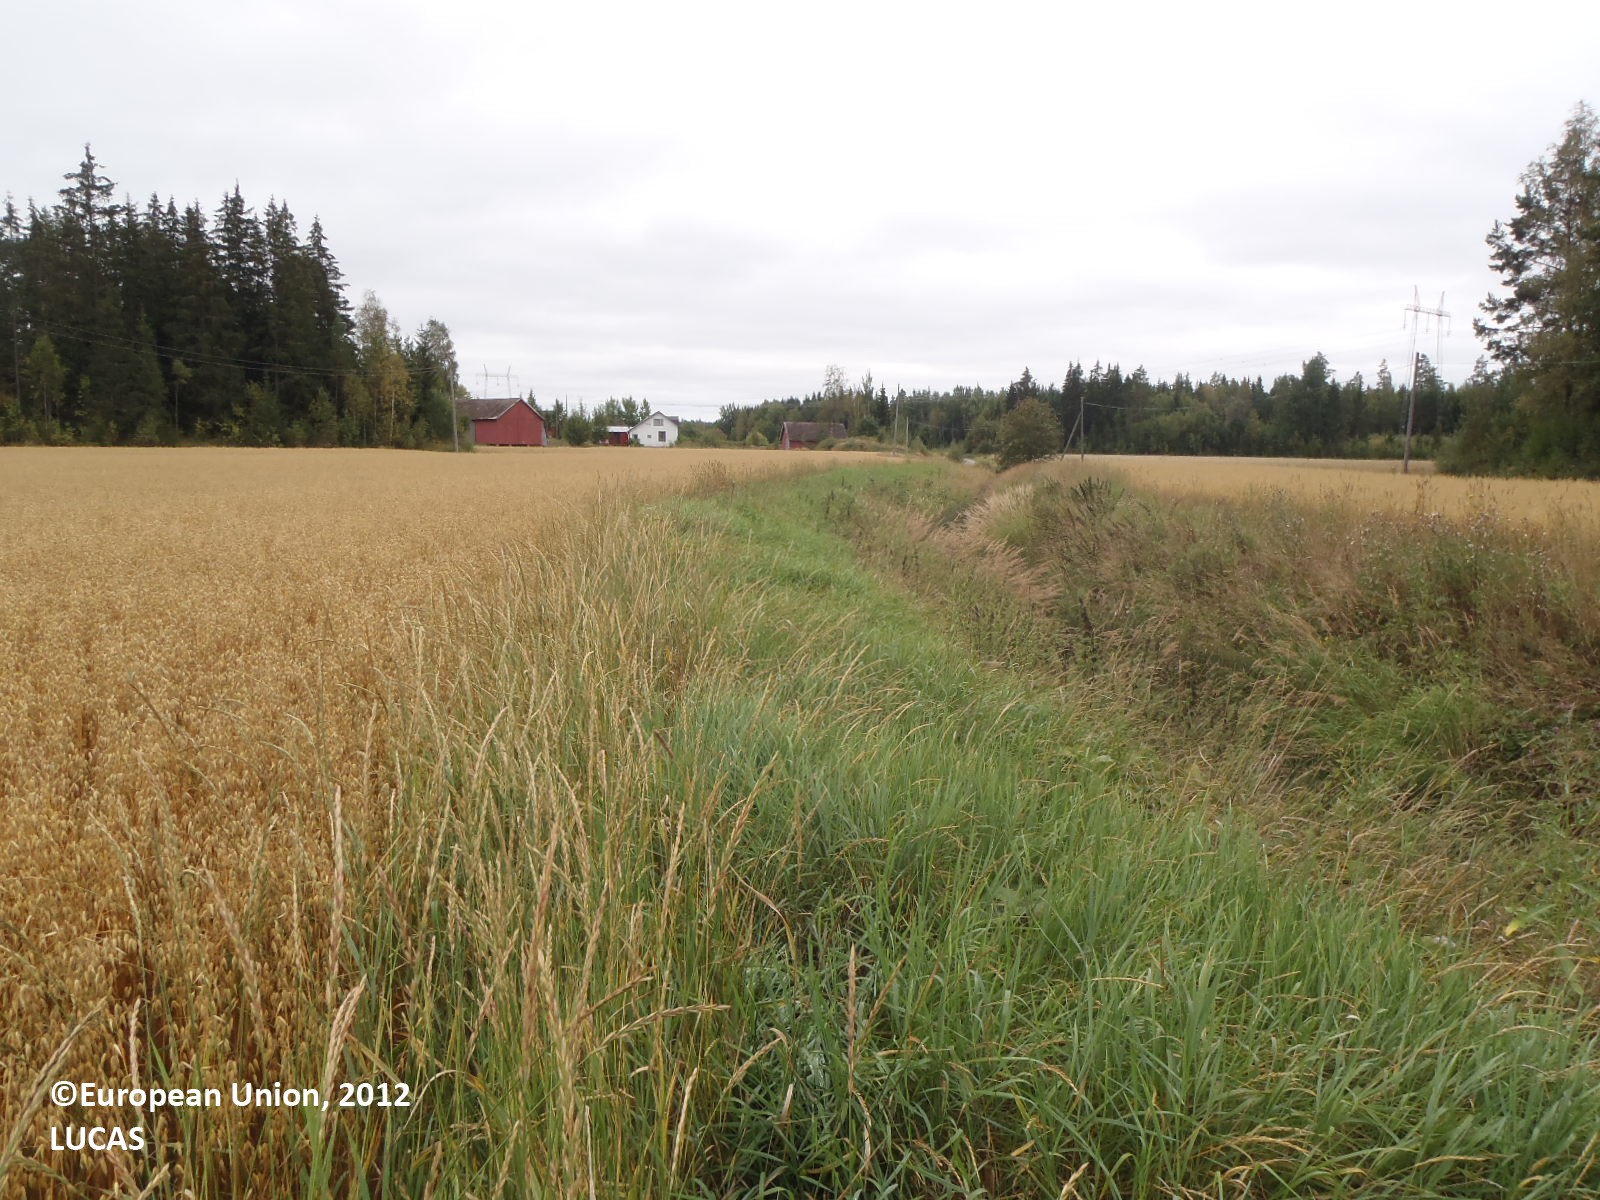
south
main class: Cropland
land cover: Oats
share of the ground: > 75 %
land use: Agriculture (excluding fallow land and kitchen gardens)
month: August
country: FI
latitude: 60.7631
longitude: 21.9731
